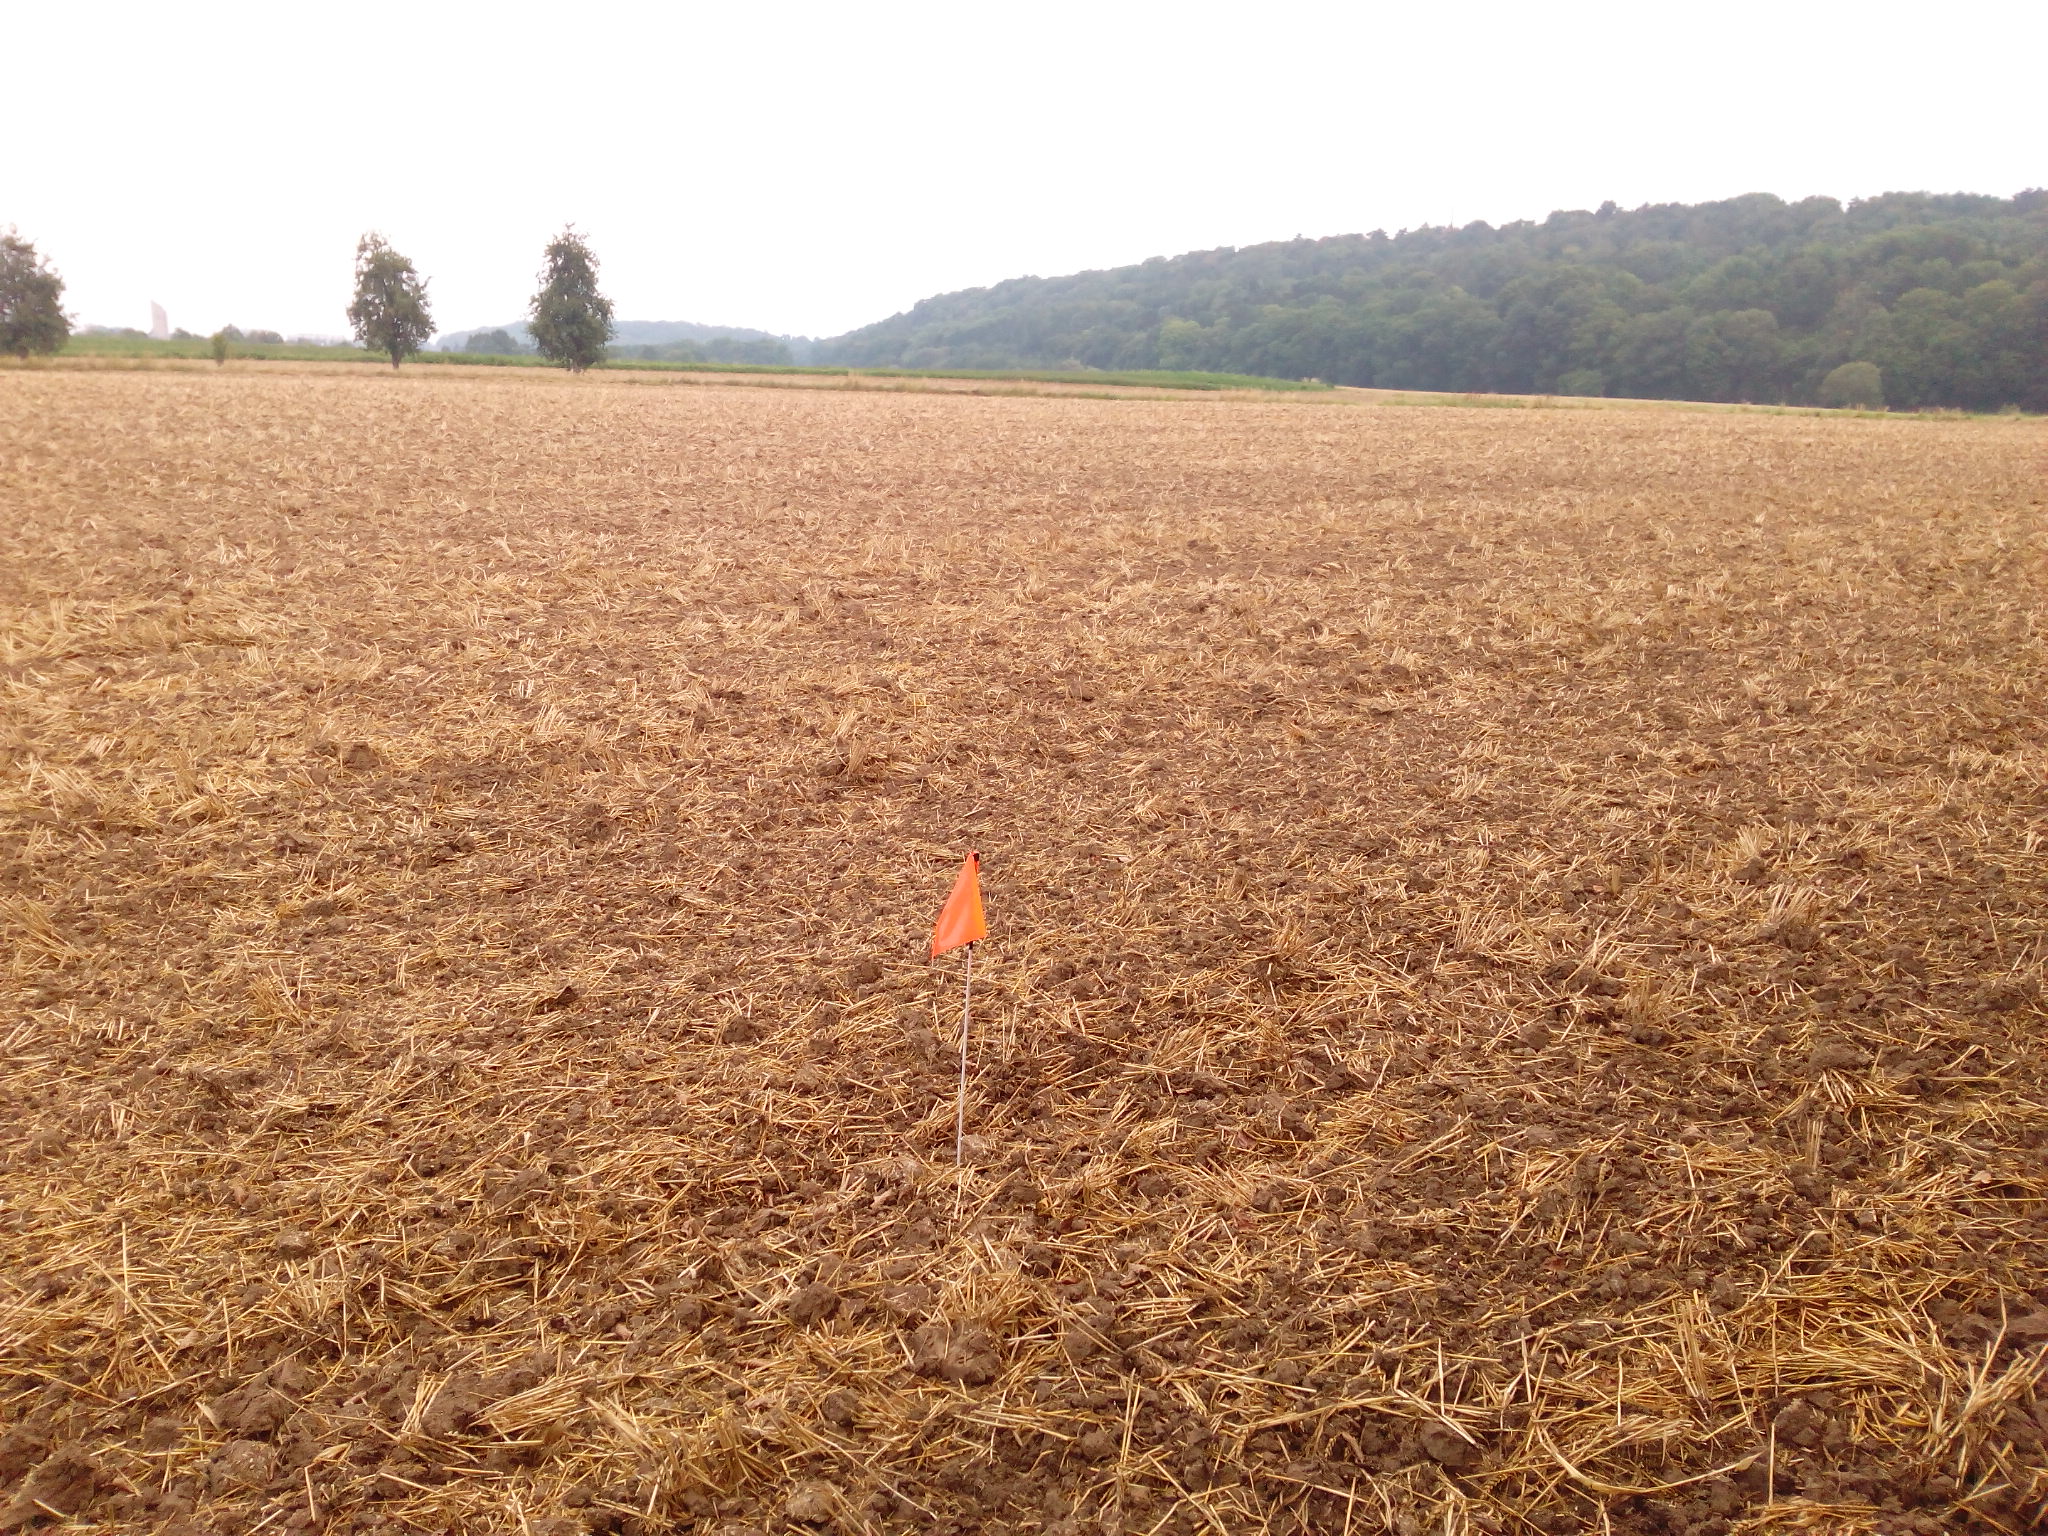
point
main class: Cropland
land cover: Common wheat
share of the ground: < 10 %
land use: Agriculture (excluding fallow land and kitchen gardens)
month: August
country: DE
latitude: 52.1258
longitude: 9.9270
